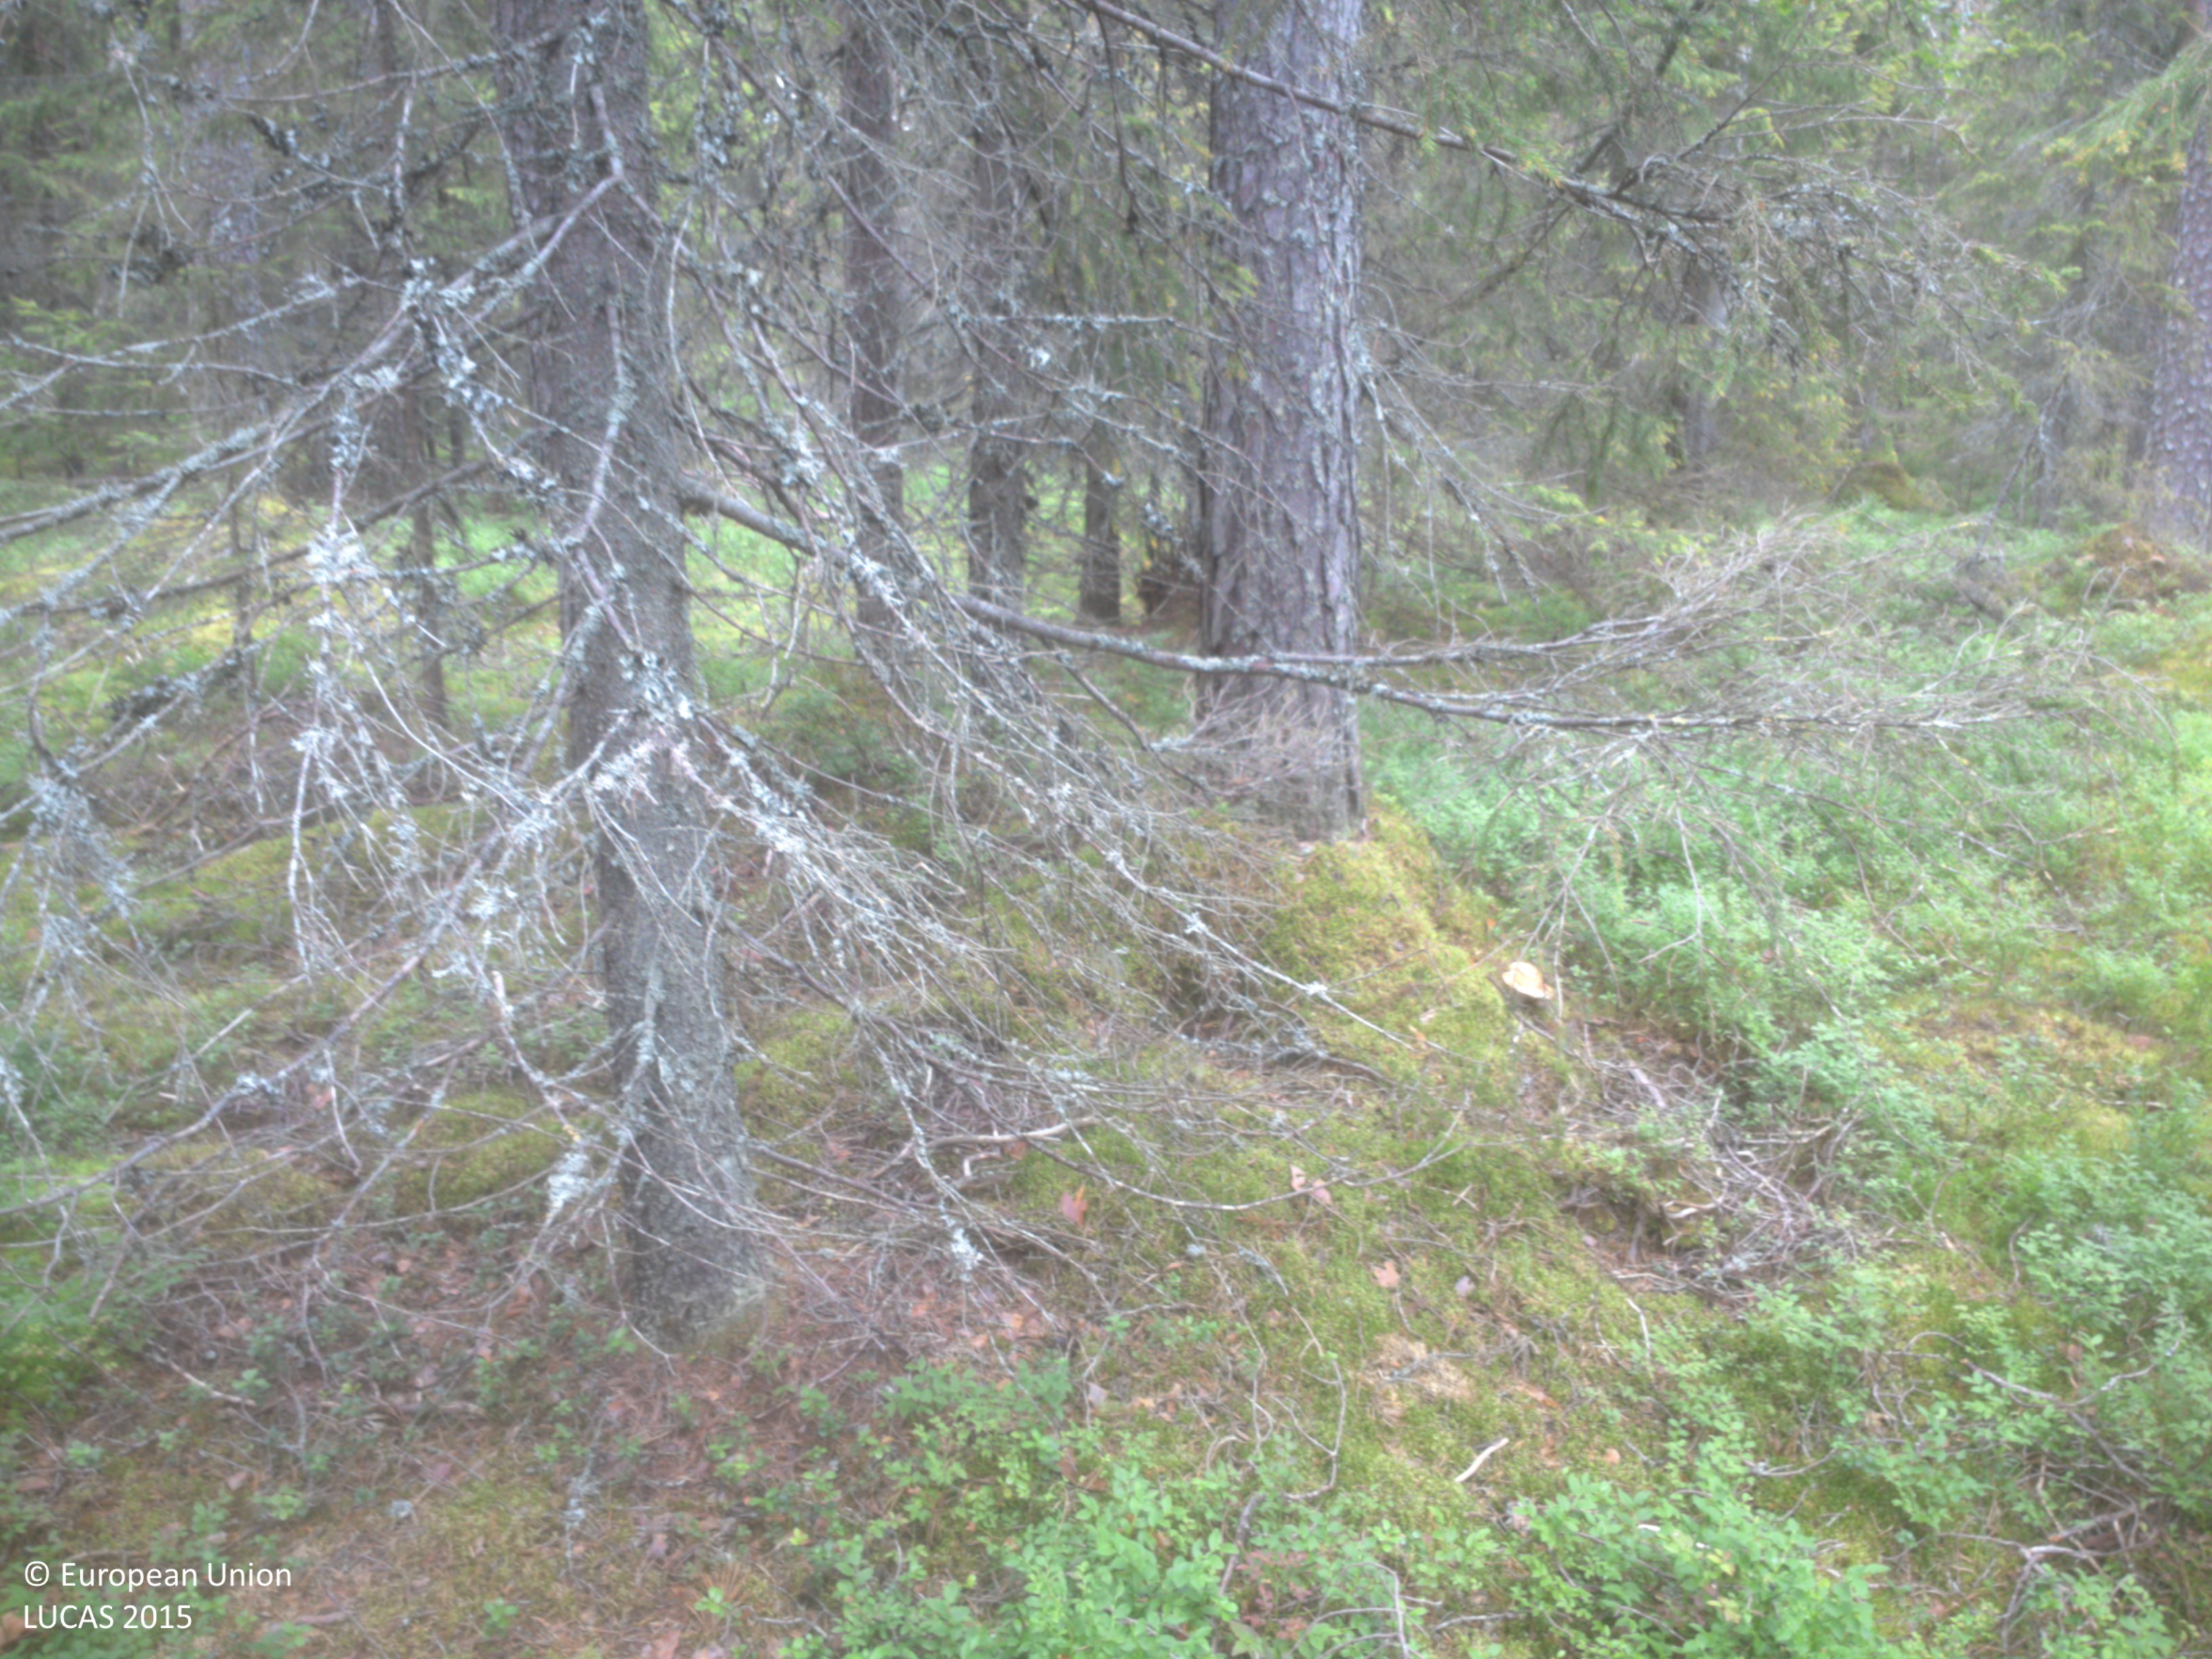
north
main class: Woodland
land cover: Other coniferous woodland
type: boreal forest
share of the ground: 50 - 75 %
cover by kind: coniferous forest trees 70 %, shrubs 20 %, lichens and mosses 10 %
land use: Forestry
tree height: > 5 m
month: August
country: SE
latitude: 63.7428
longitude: 19.8873
